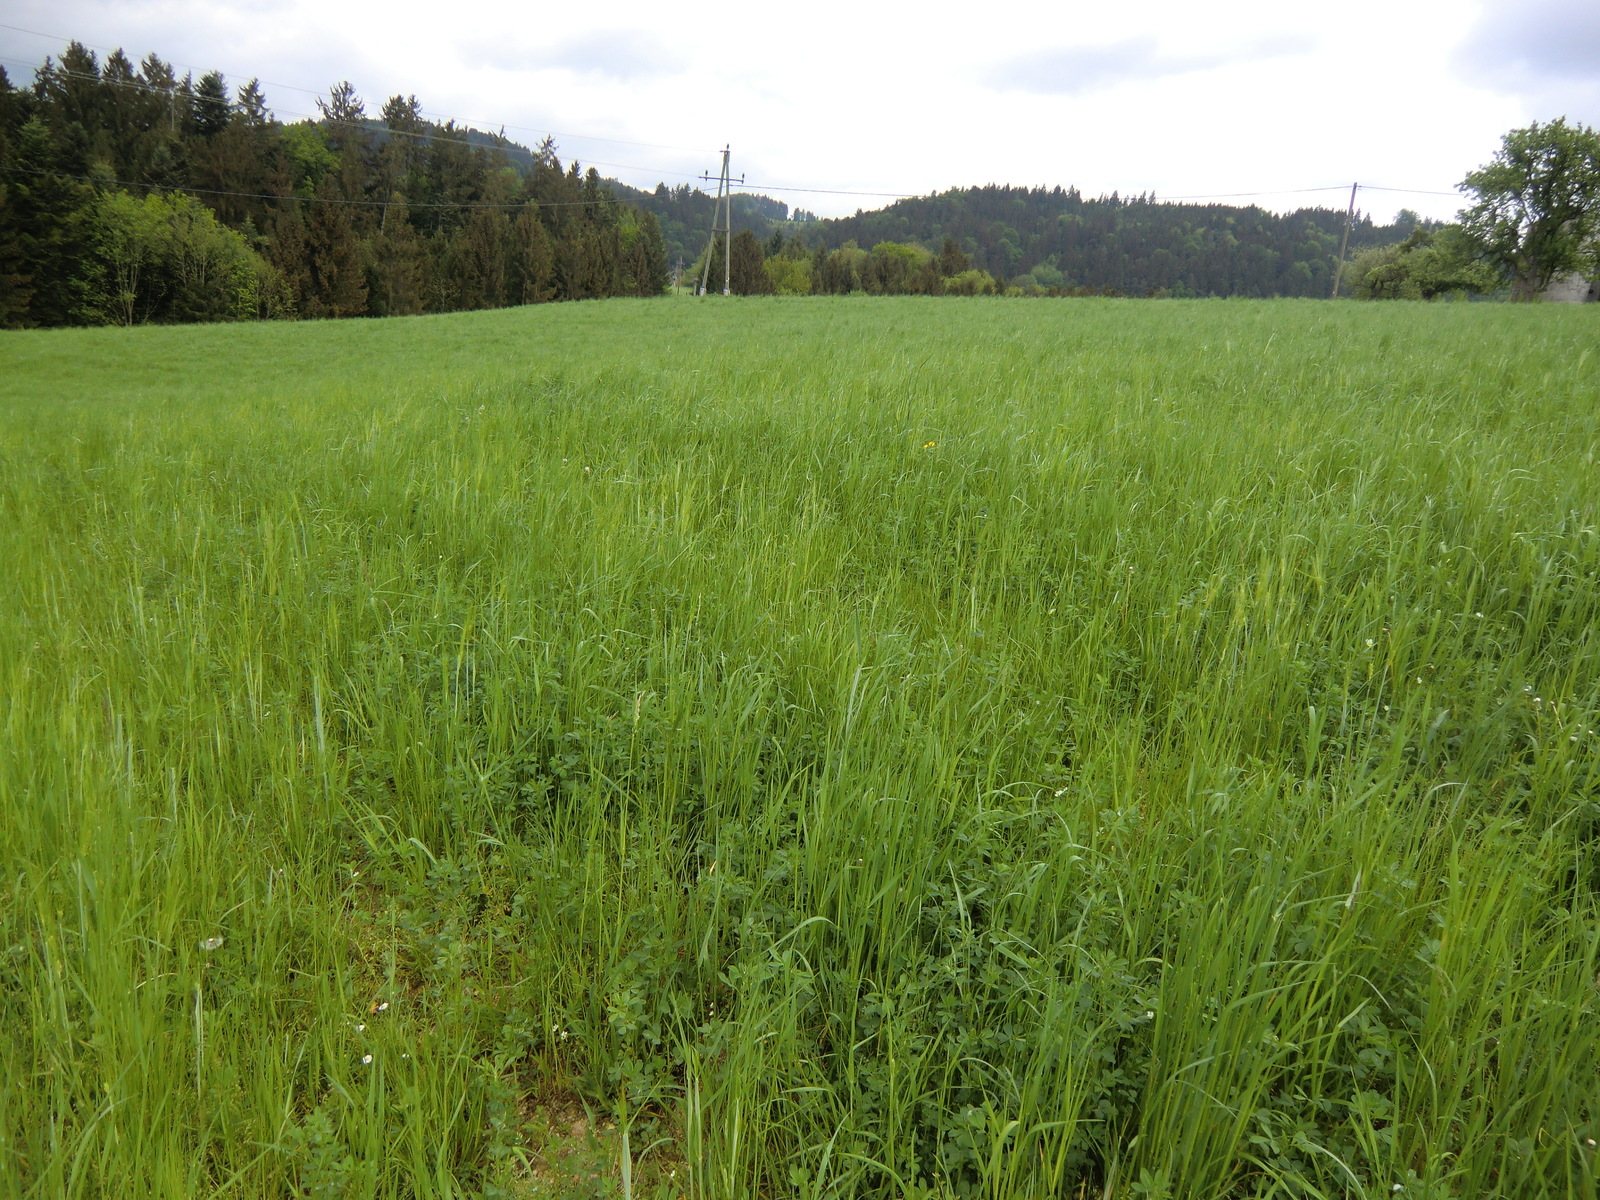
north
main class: Grassland
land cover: Grassland without tree/shrub cover
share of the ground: > 75 %
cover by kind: herbaceous plants 100 %
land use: Agriculture (excluding fallow land and kitchen gardens)
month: May
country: AT
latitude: 48.2437
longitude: 14.8352
